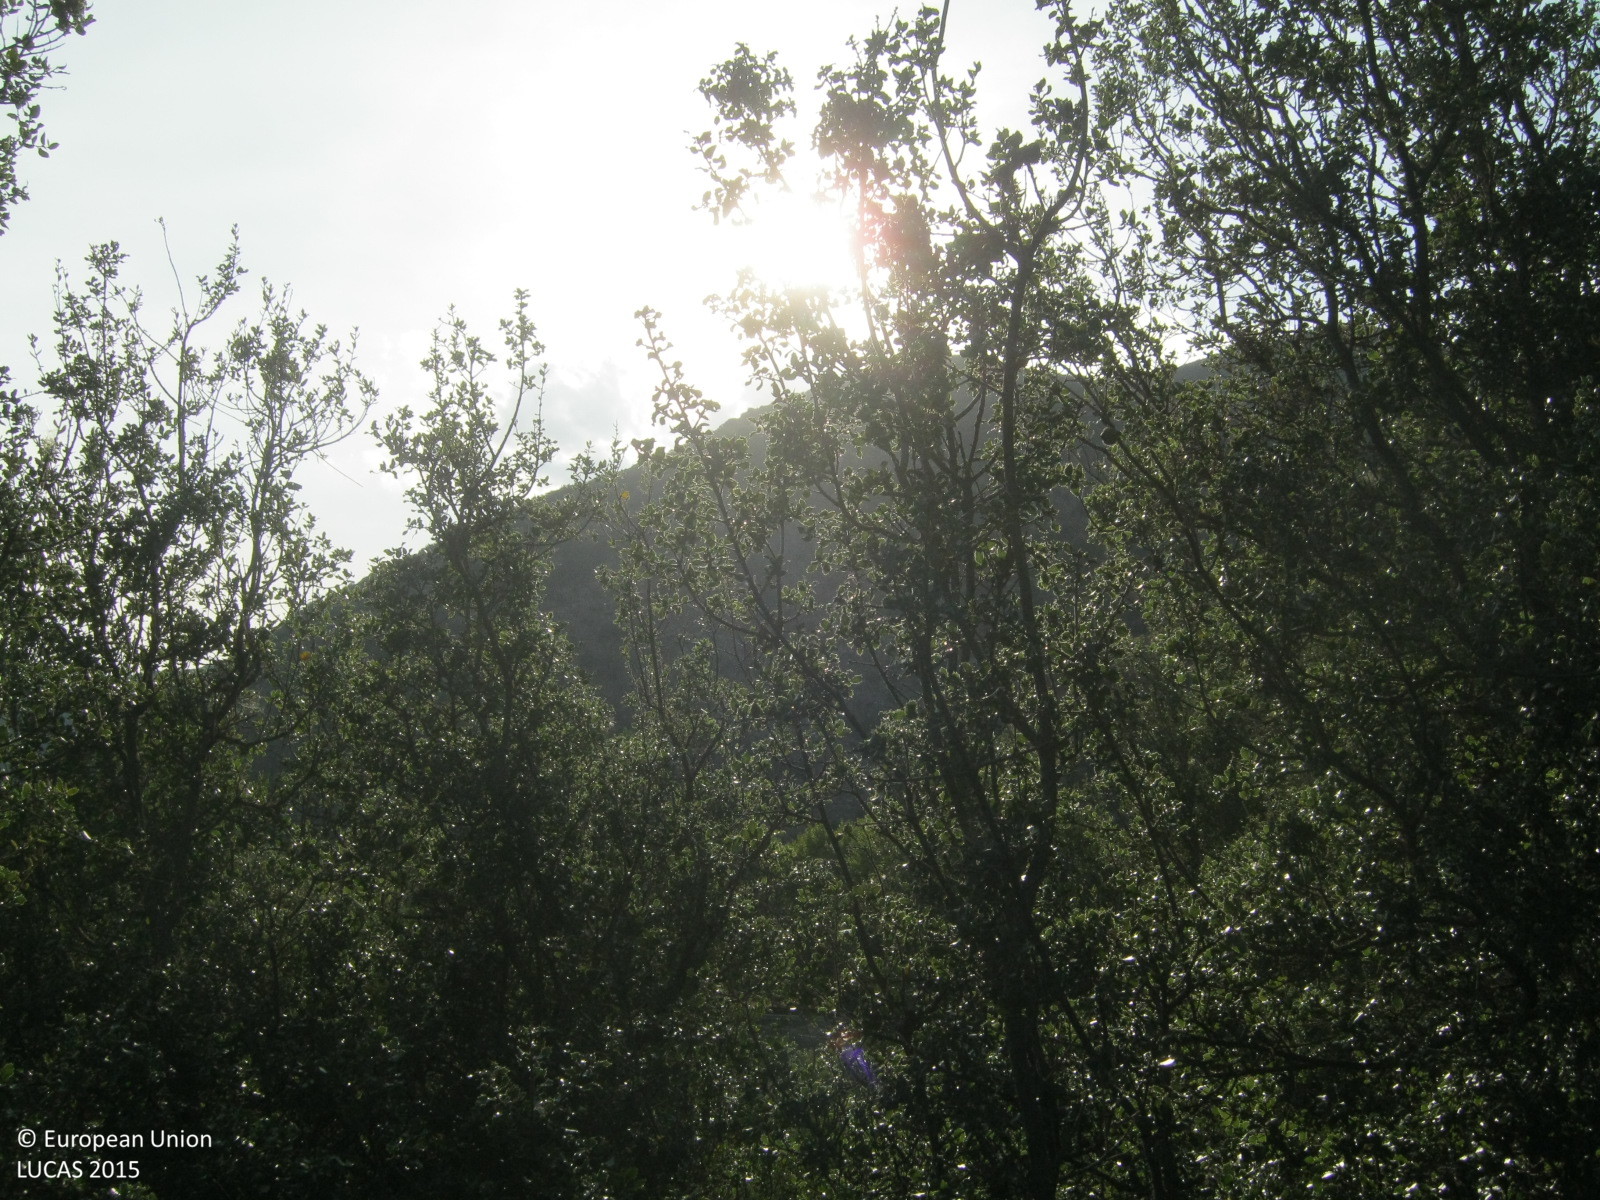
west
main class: Woodland
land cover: Broadleaved woodland
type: broadleaved evergreen forest
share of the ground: > 75 %
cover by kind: broadleaved forest trees 75 %, shrubs 20 %, herbaceous plants 5 %
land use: Semi-natural and natural areas not in use
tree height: < 5 m
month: September
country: GR
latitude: 37.9179
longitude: 22.1488
